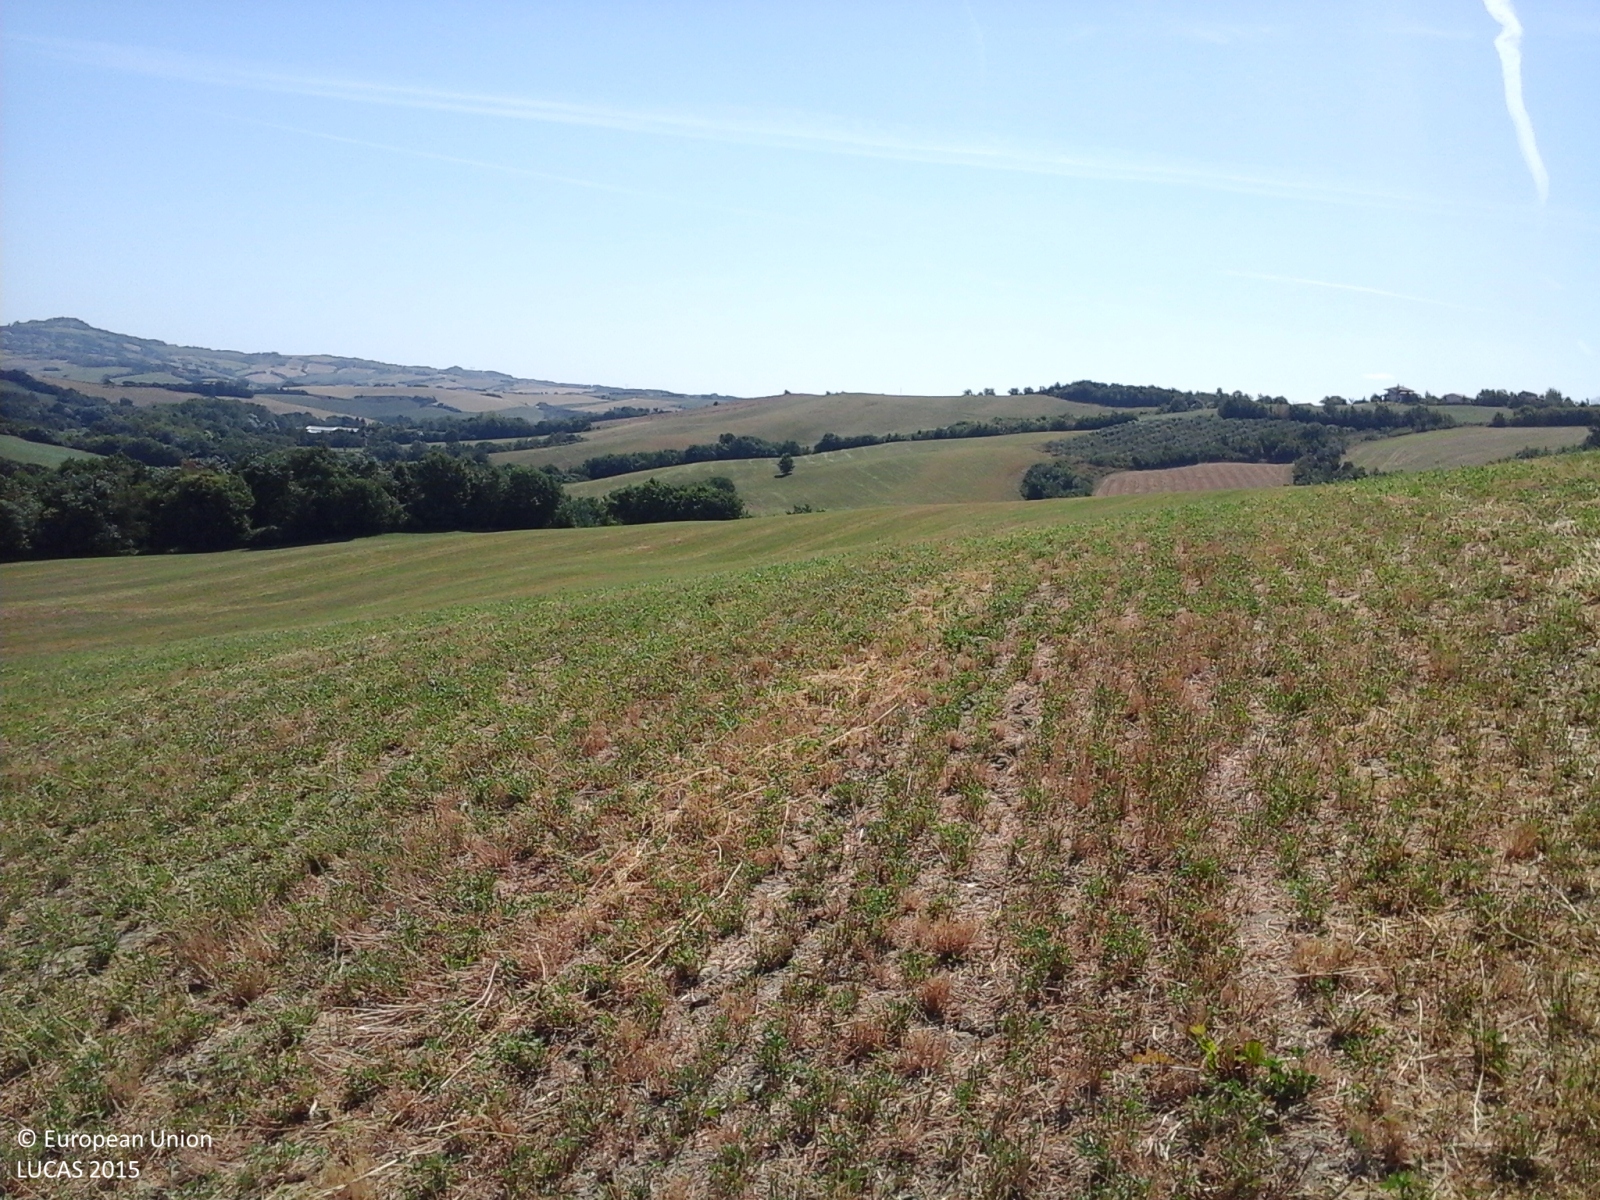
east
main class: Cropland
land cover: Lucerne
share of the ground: > 75 %
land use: Agriculture (excluding fallow land and kitchen gardens)
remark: Harvested field
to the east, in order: Lucerne
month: July
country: IT
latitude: 43.8824
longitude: 12.6945
